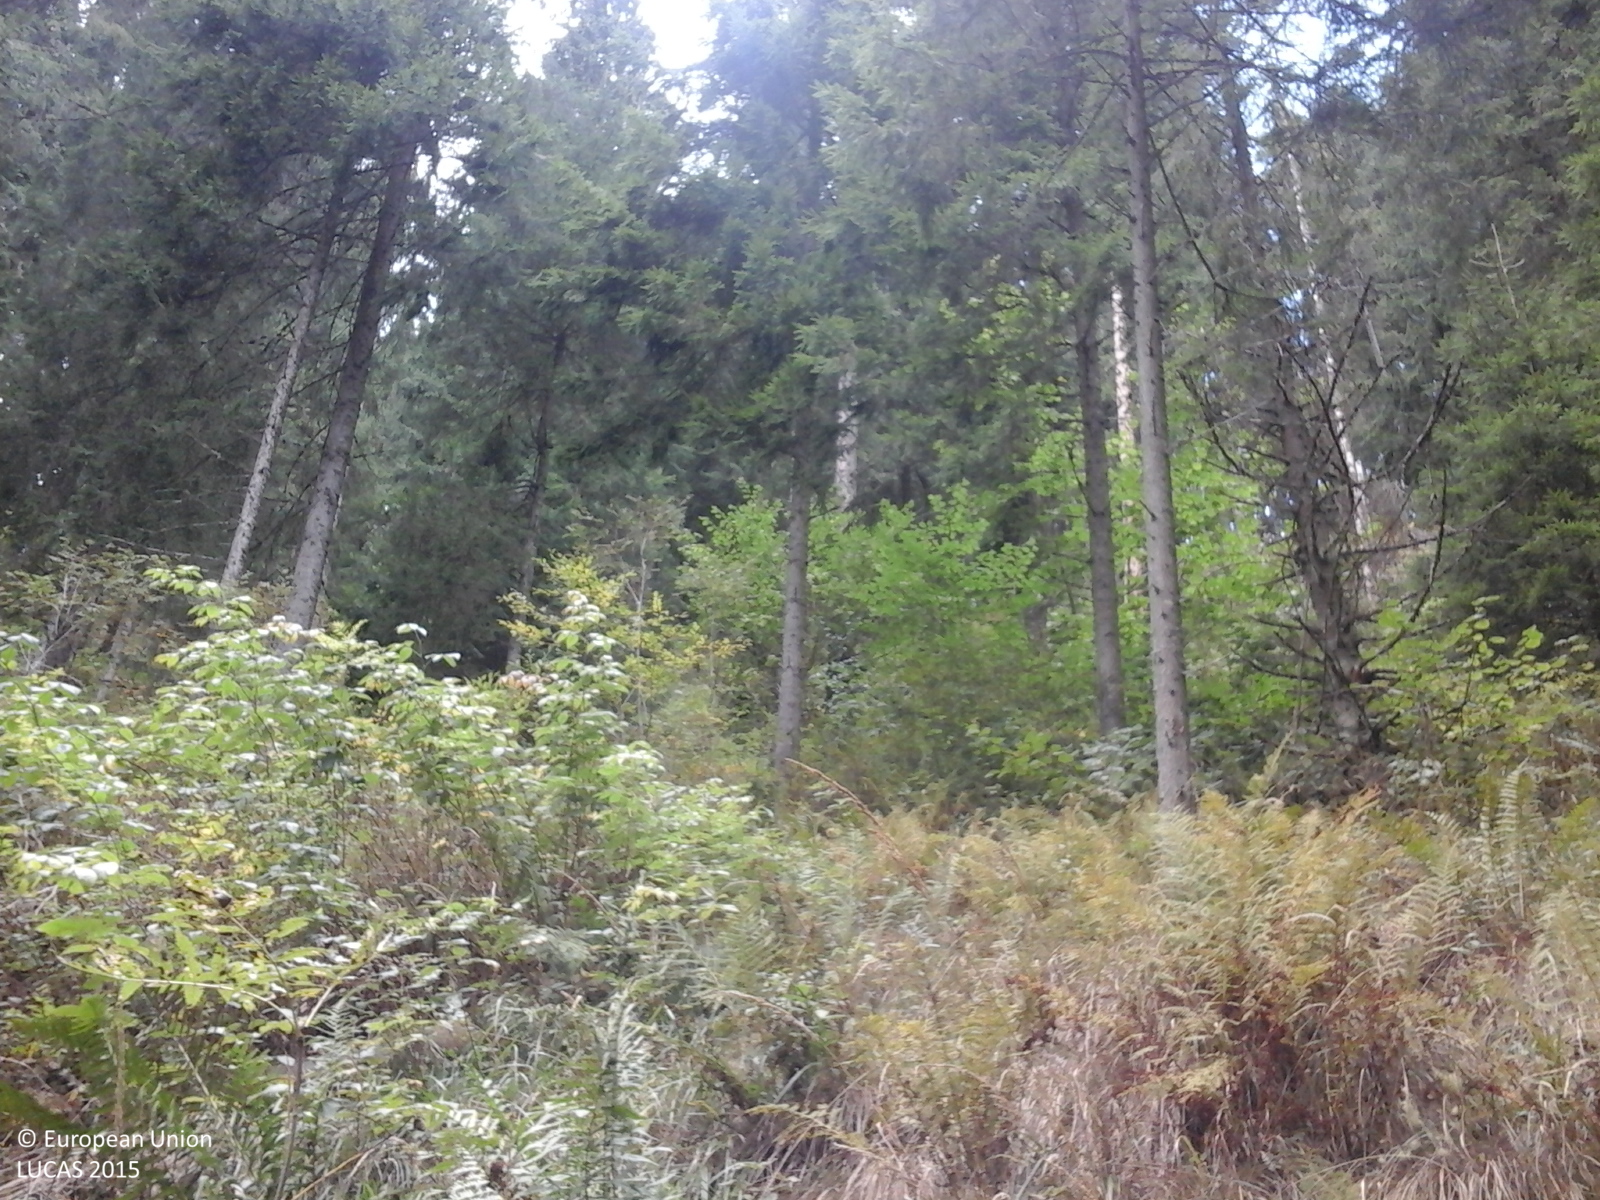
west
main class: Woodland
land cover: Spruce dominated coniferous woodland
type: alpine coniferous forest
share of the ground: > 75 %
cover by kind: coniferous forest trees 75 %, shrubs 10 %, herbaceous plants 10 %, broadleaved forest trees 5 %
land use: Forestry
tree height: > 5 m
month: September
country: RO
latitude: 46.6677
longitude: 22.9867
